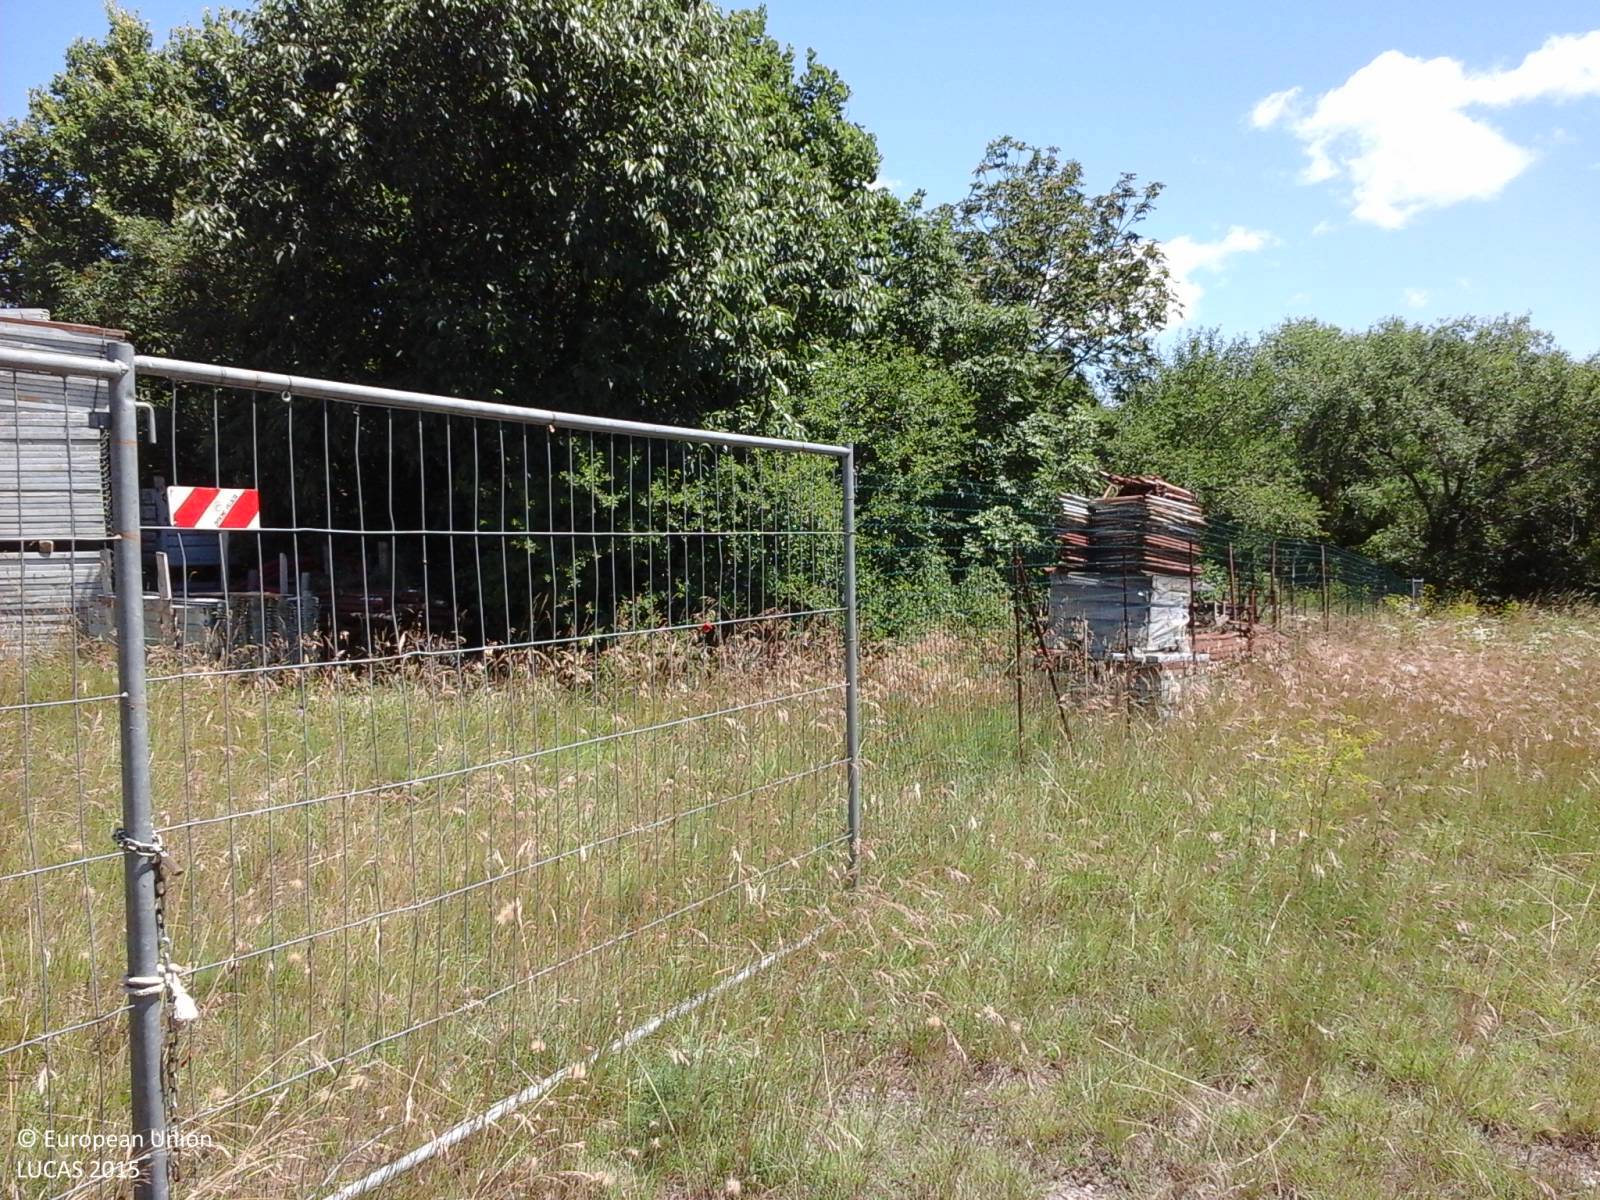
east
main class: Cropland
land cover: Other fresh vegetables
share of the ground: > 75 %
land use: Kitchen garden
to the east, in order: Other fresh vegetables; Fences; Grassland without tree/shrub cover; Shrubland with sparse tree cover; Artificial constructions in urban areas; Lucerne; Abandoned hedges; Vineyards; Electric lines; Vineyards; Fences; Vineyards; Grassland without tree/shrub cover
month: June
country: IT
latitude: 45.7648
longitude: 13.6861
